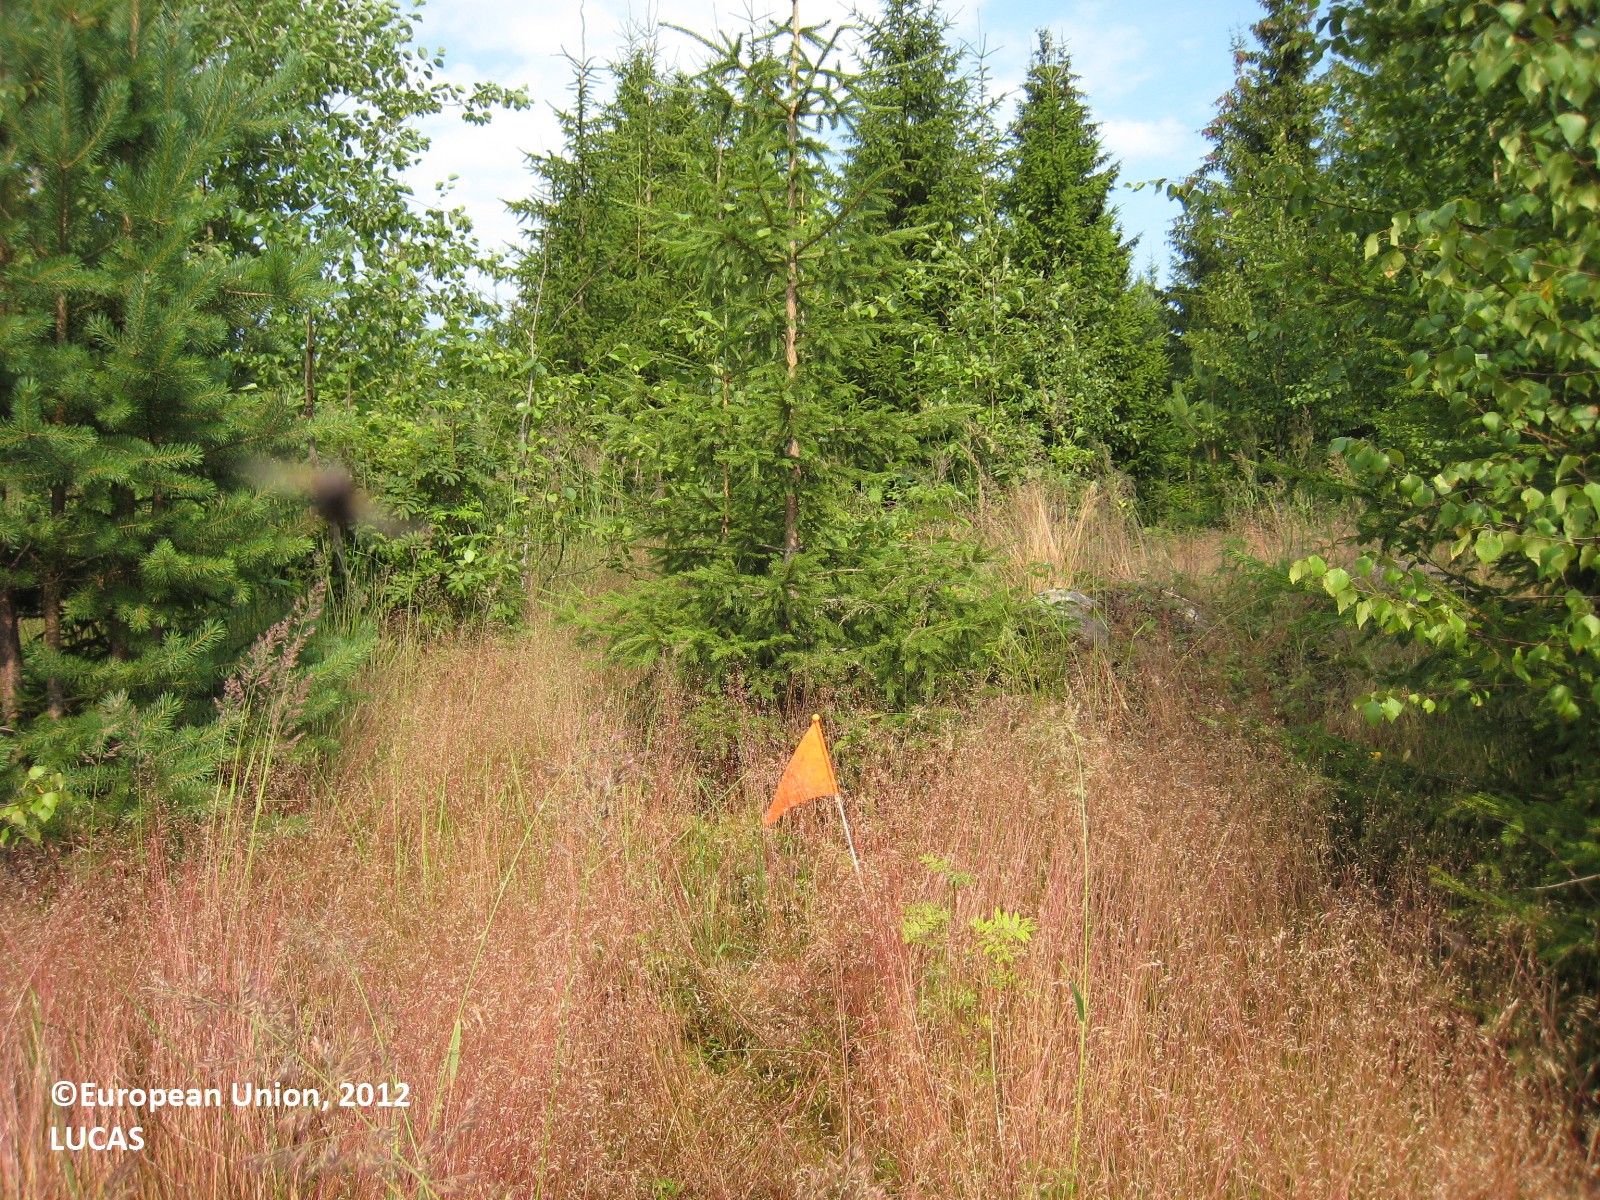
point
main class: Woodland
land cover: Other mixed woodland
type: boreal forest
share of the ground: 50 - 75 %
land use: Forestry
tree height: < 5 m
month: July
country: FI
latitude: 62.4066
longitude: 27.3682
